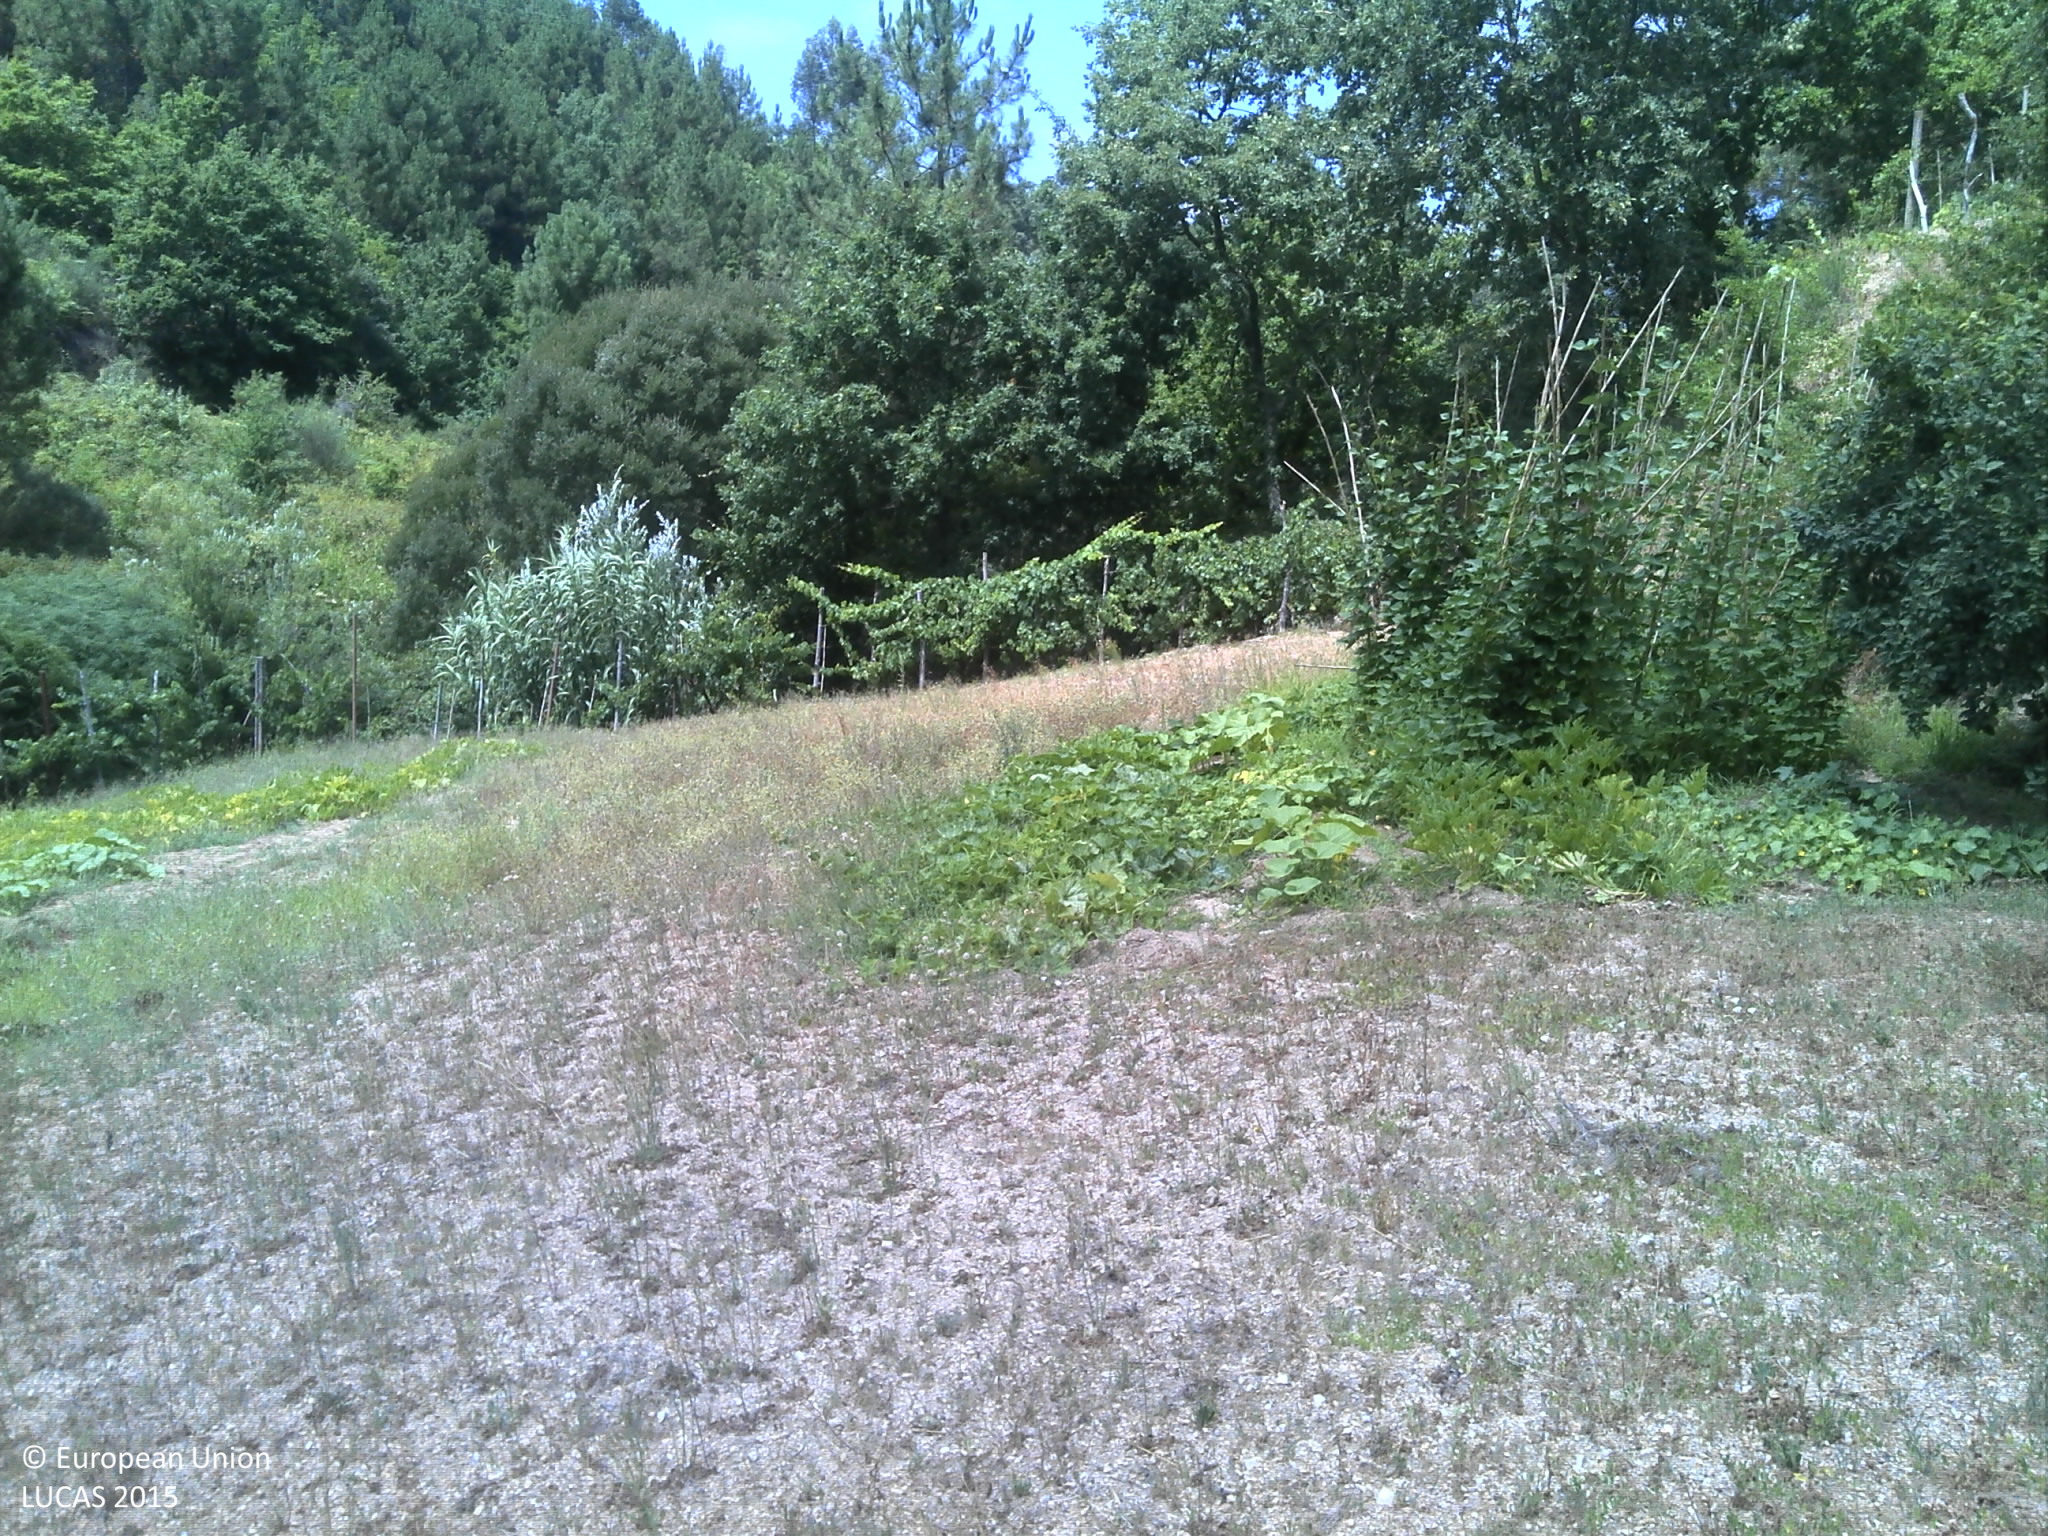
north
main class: Grassland
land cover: Spontaneously vegetated surfaces
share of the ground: 25 - 50 %
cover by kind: unconsolidated bare surface 60 %, herbaceous plants 40 %
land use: Fallow land
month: July
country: PT
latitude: 40.3842
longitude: -7.7735
